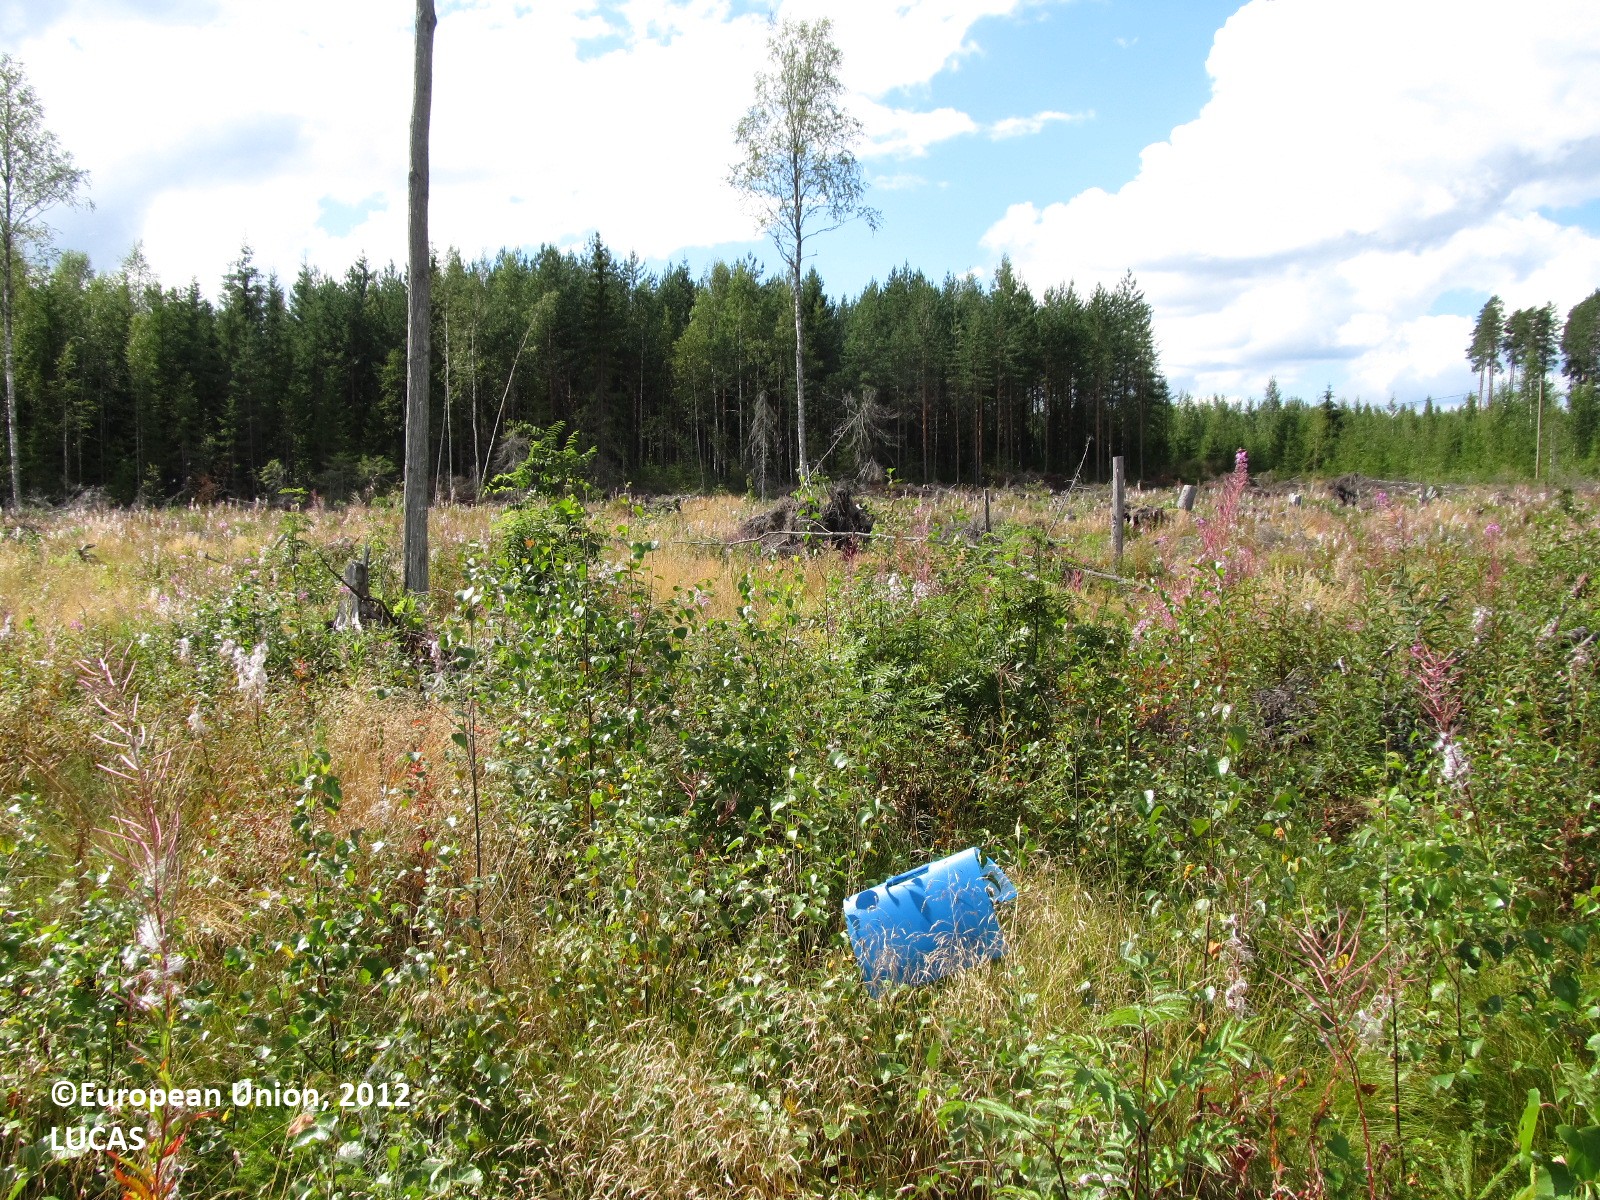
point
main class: Shrubland
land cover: Shrubland with sparse tree cover
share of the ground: 25 - 50 %
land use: Forestry
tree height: < 5 m
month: August
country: FI
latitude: 62.2104
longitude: 27.6124
